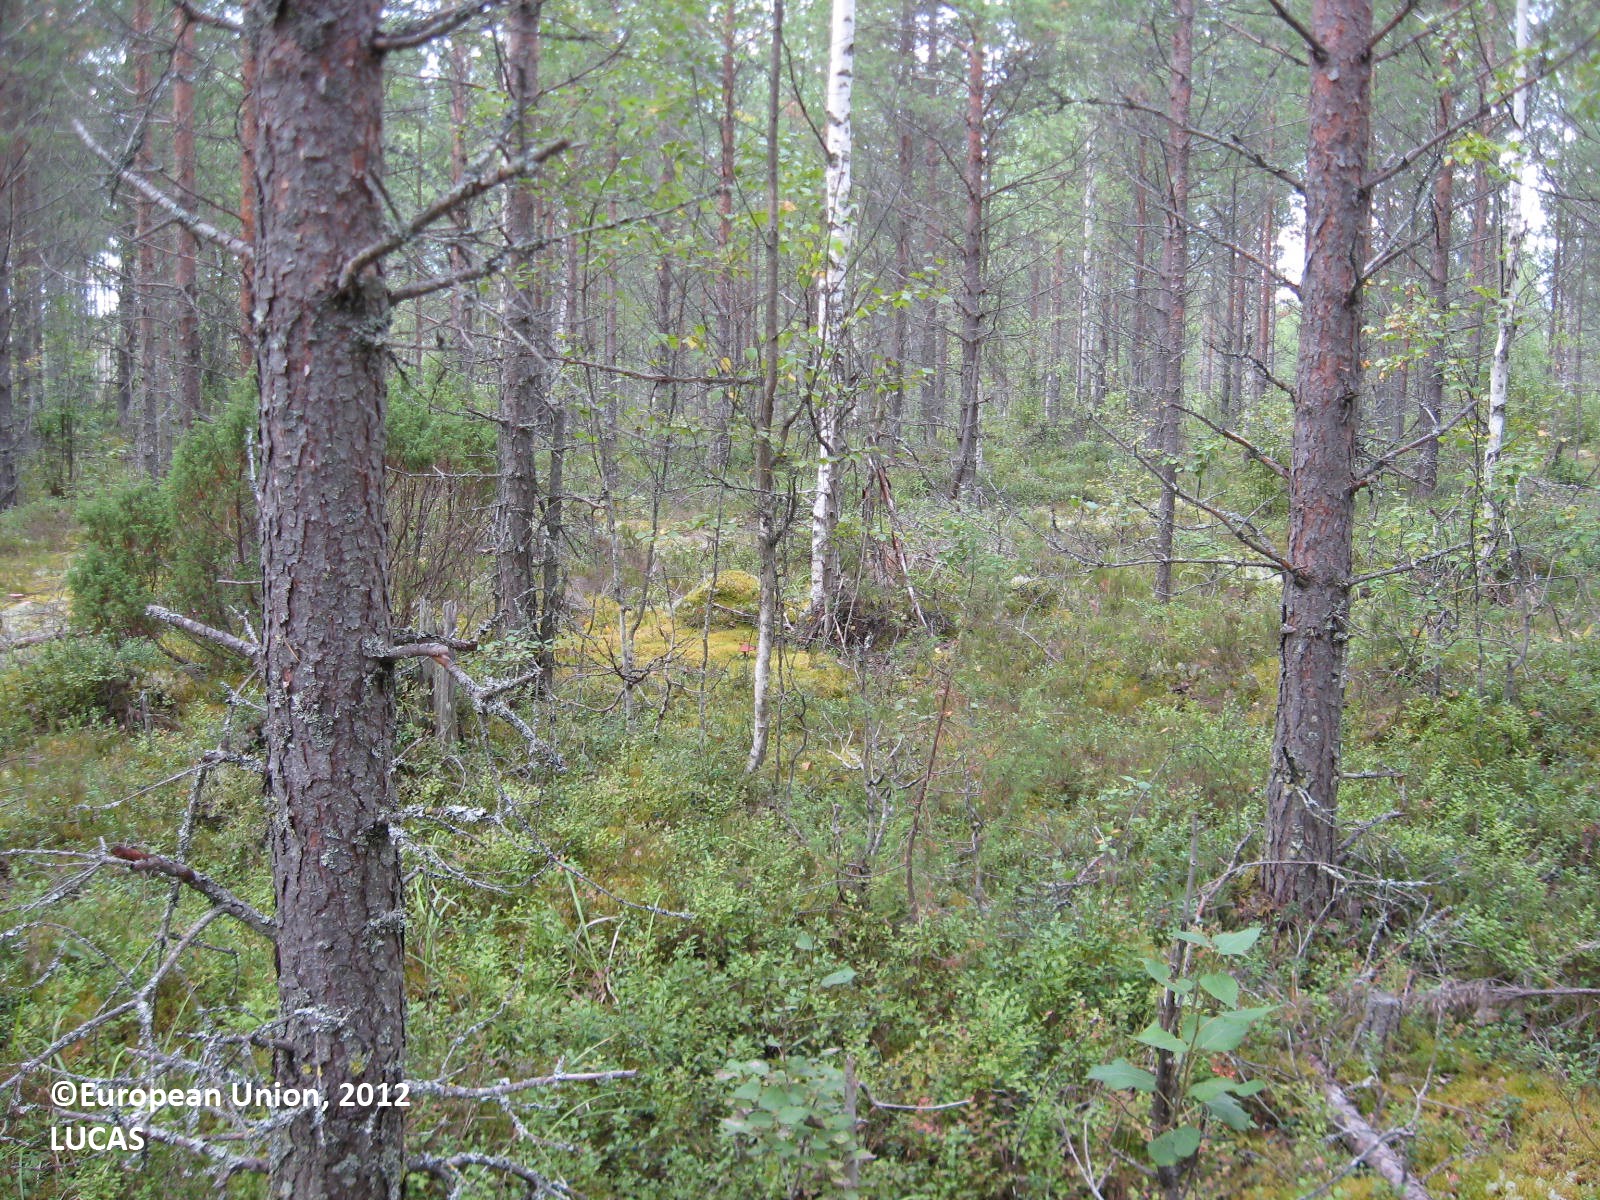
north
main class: Woodland
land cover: Pine dominated mixed woodland
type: boreal forest
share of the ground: > 75 %
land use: Forestry
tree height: > 5 m
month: August
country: FI
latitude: 63.3924
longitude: 30.2110
